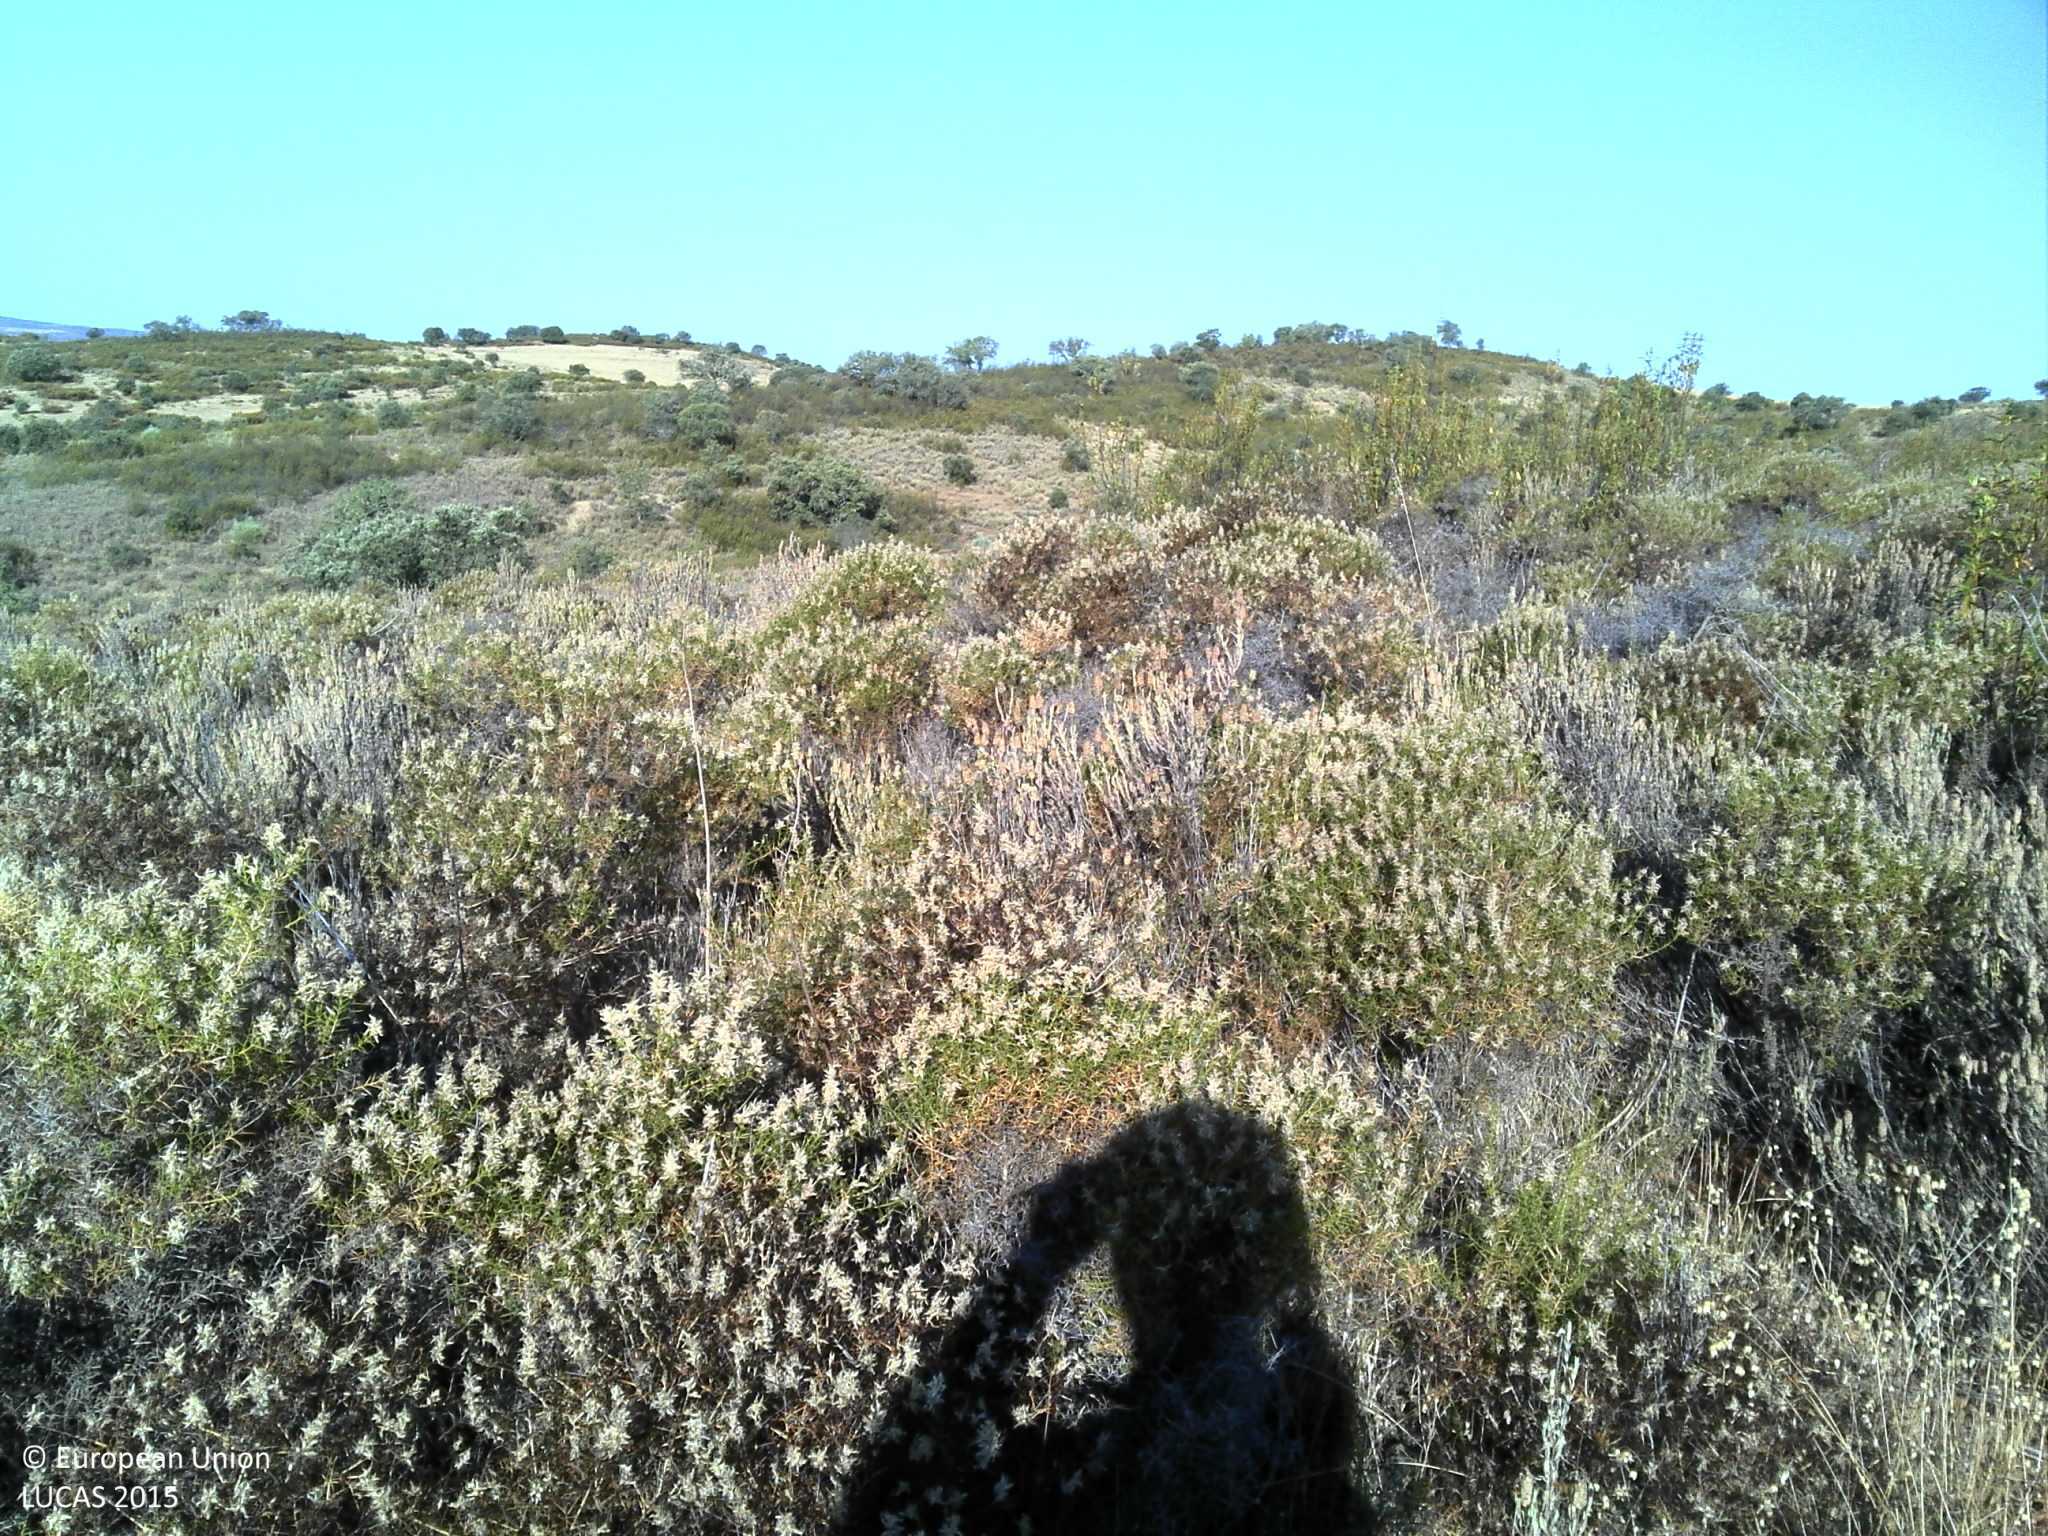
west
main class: Shrubland
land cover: Shrubland without tree cover
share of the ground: > 75 %
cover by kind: shrubs 100 %
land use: Semi-natural and natural areas not in use
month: June
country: PT
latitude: 37.6295
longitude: -7.5883
